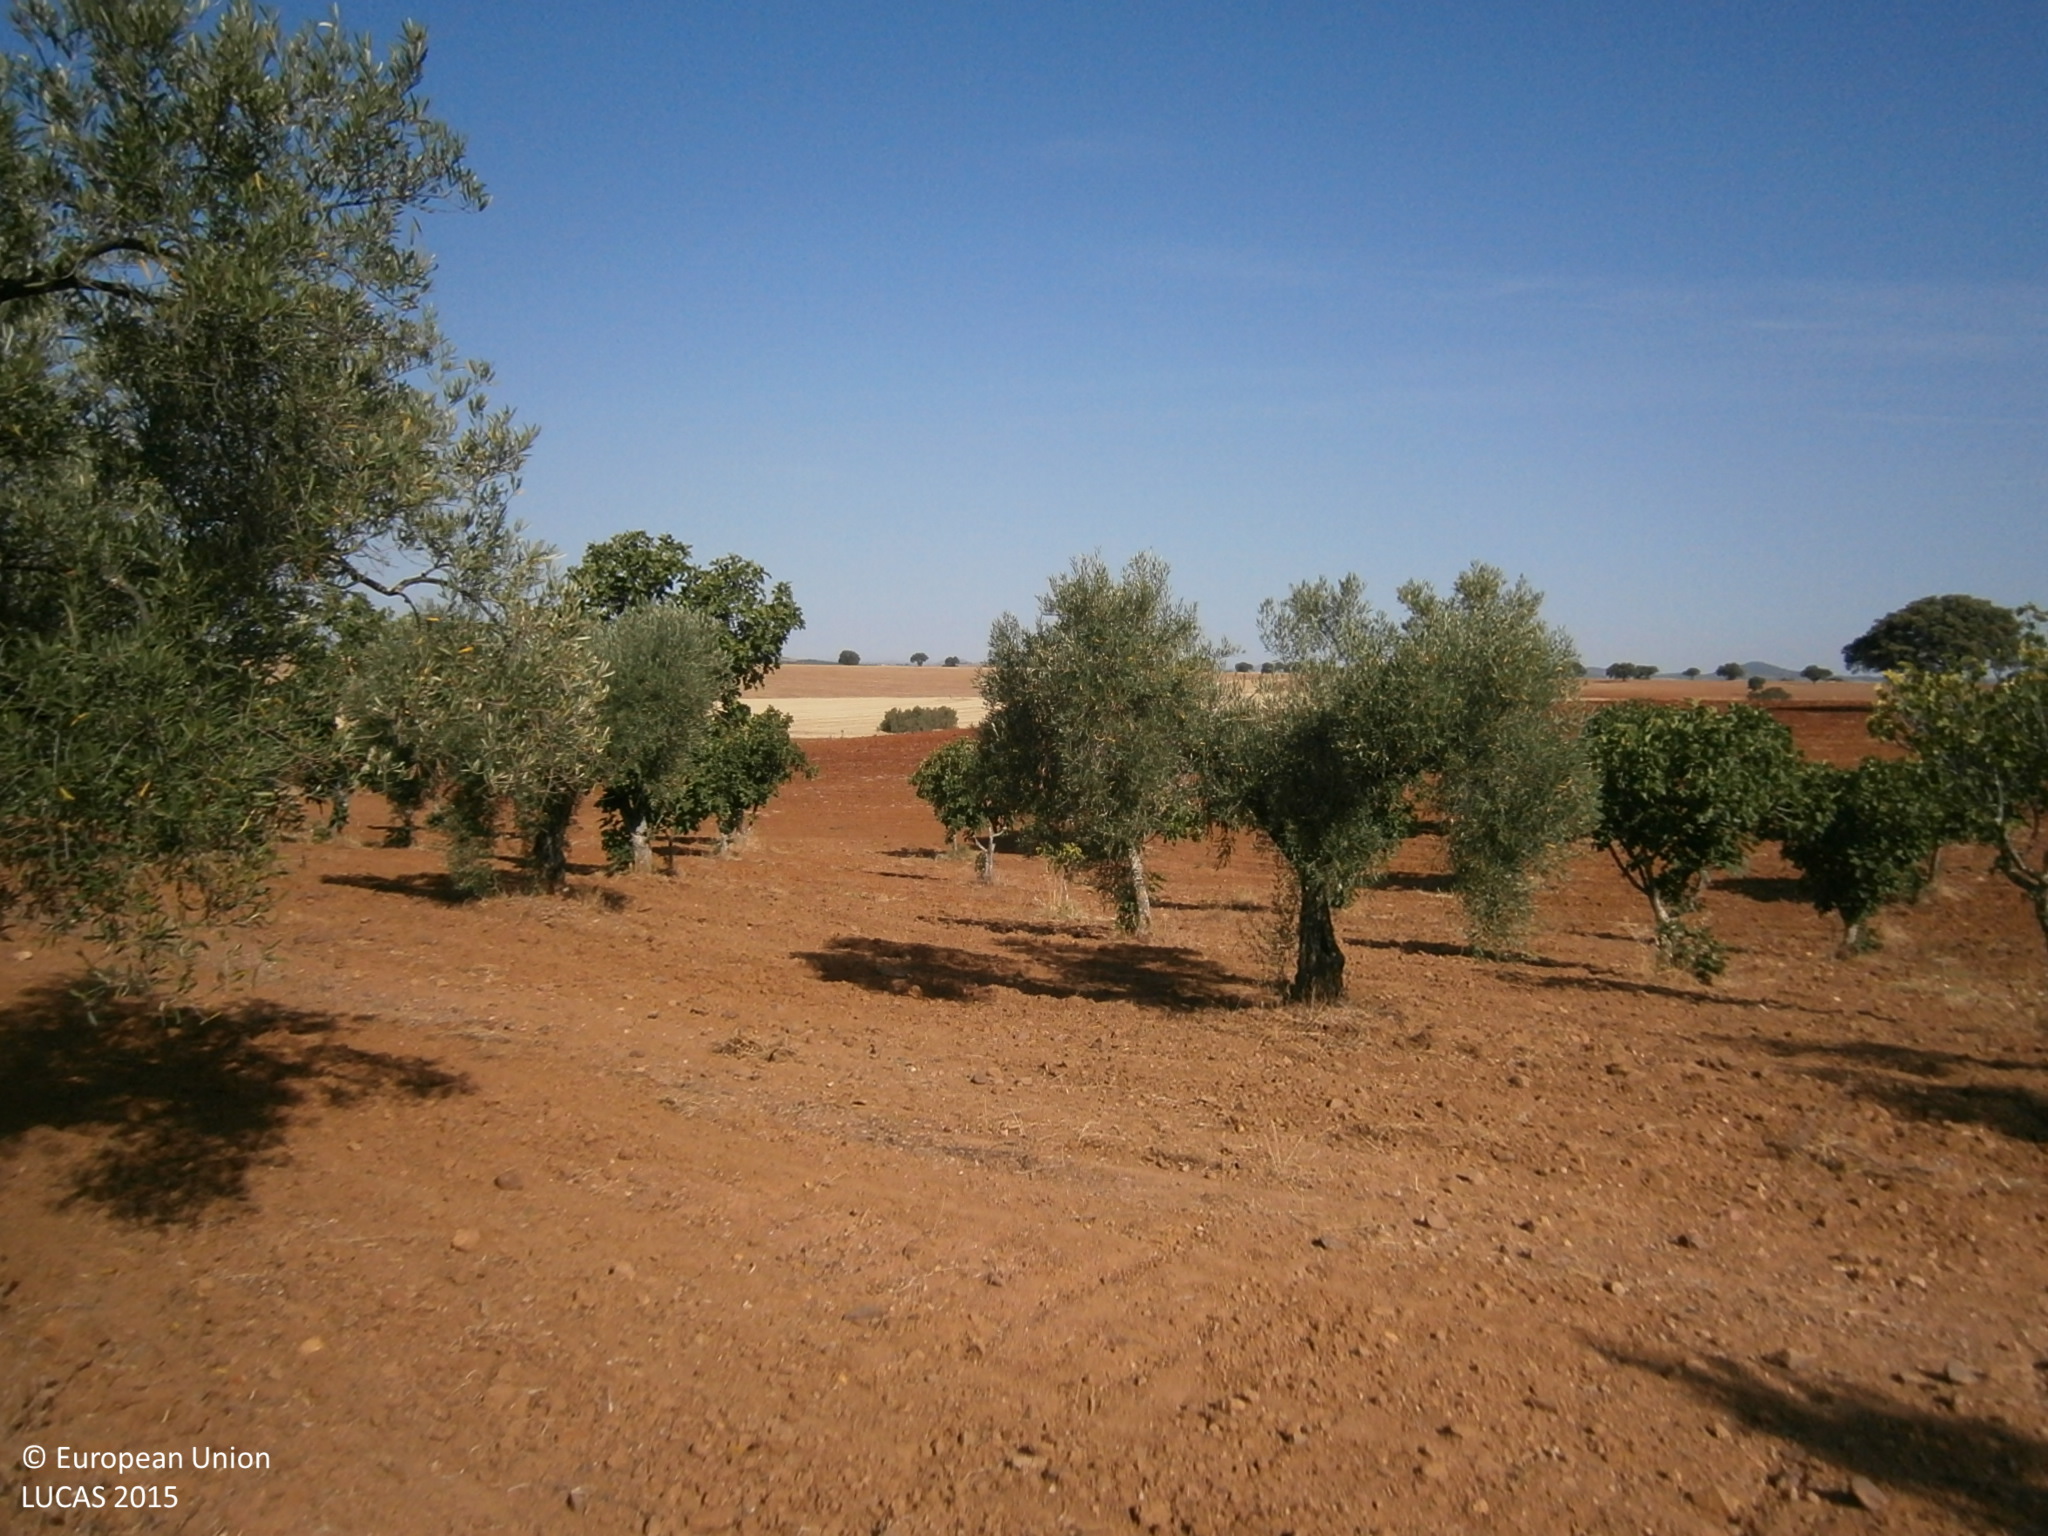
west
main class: Cropland
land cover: Olive groves
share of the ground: 25 - 50 %
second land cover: Other bare soil
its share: > 75 %
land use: Agriculture (excluding fallow land and kitchen gardens)
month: July
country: ES
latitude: 39.0605
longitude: -6.7208
